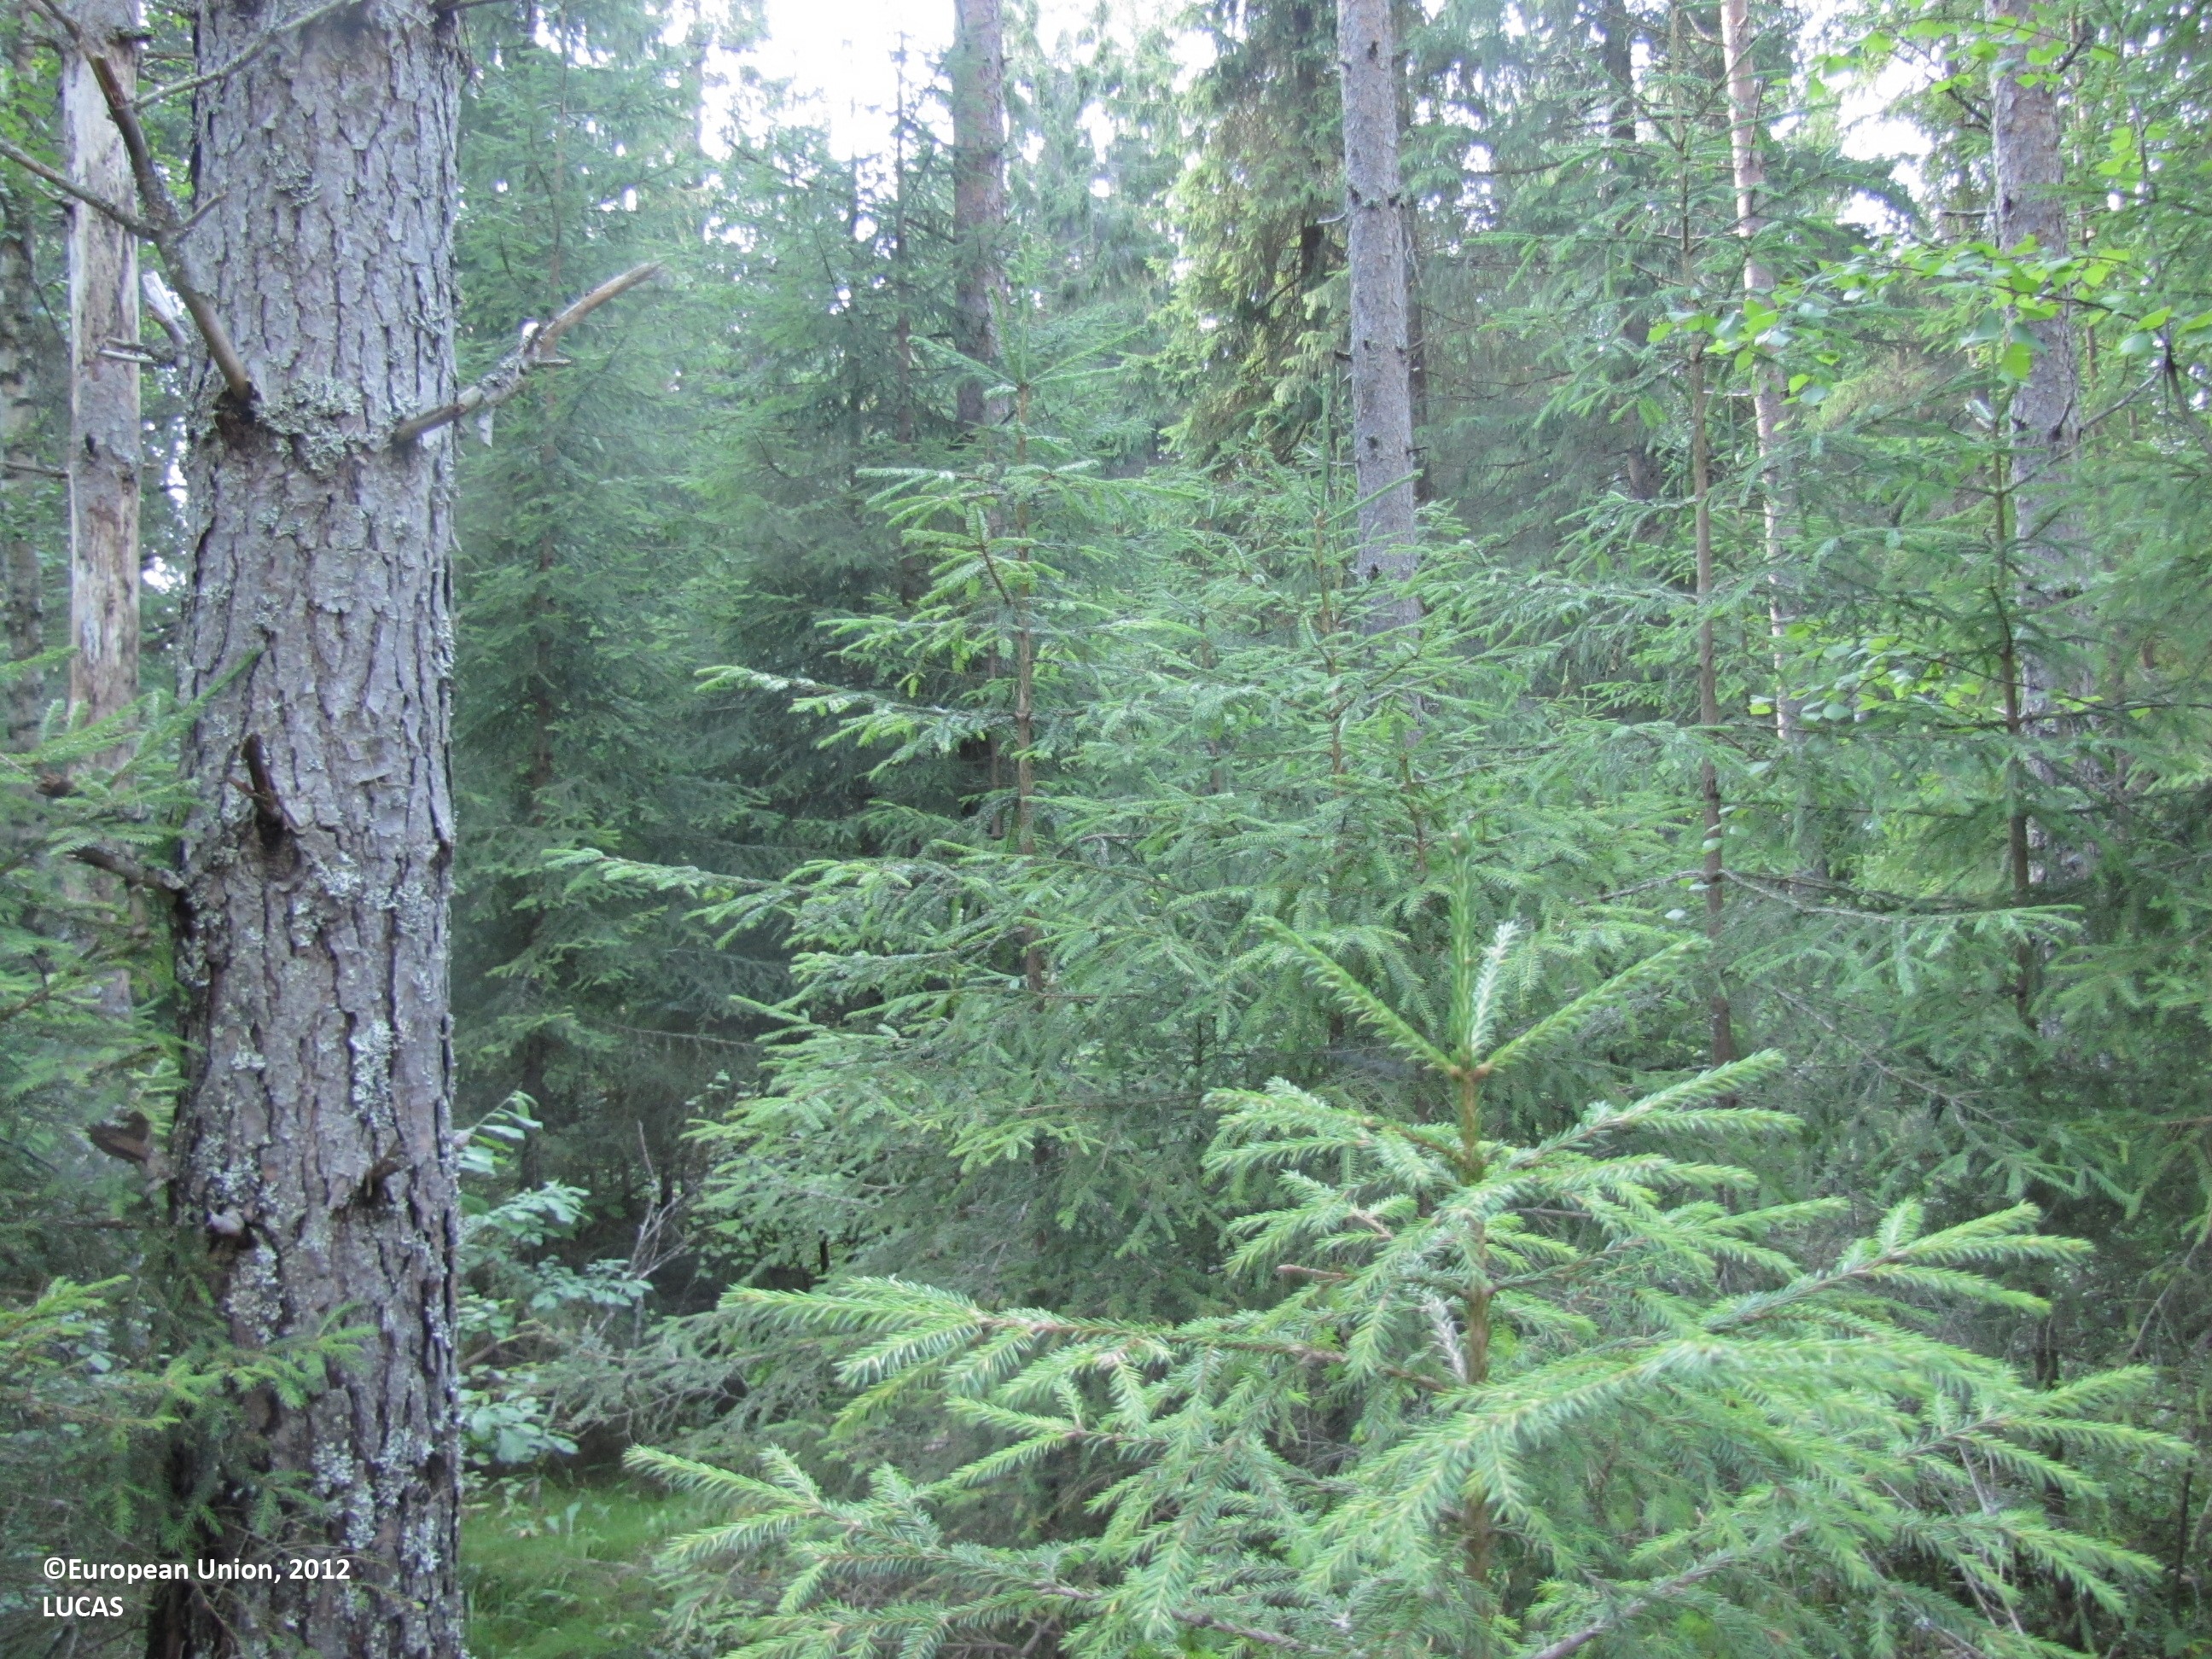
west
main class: Woodland
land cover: Other coniferous woodland
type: boreal forest
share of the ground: 50 - 75 %
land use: Forestry
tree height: > 5 m
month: July
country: FI
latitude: 62.1732
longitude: 23.4185
